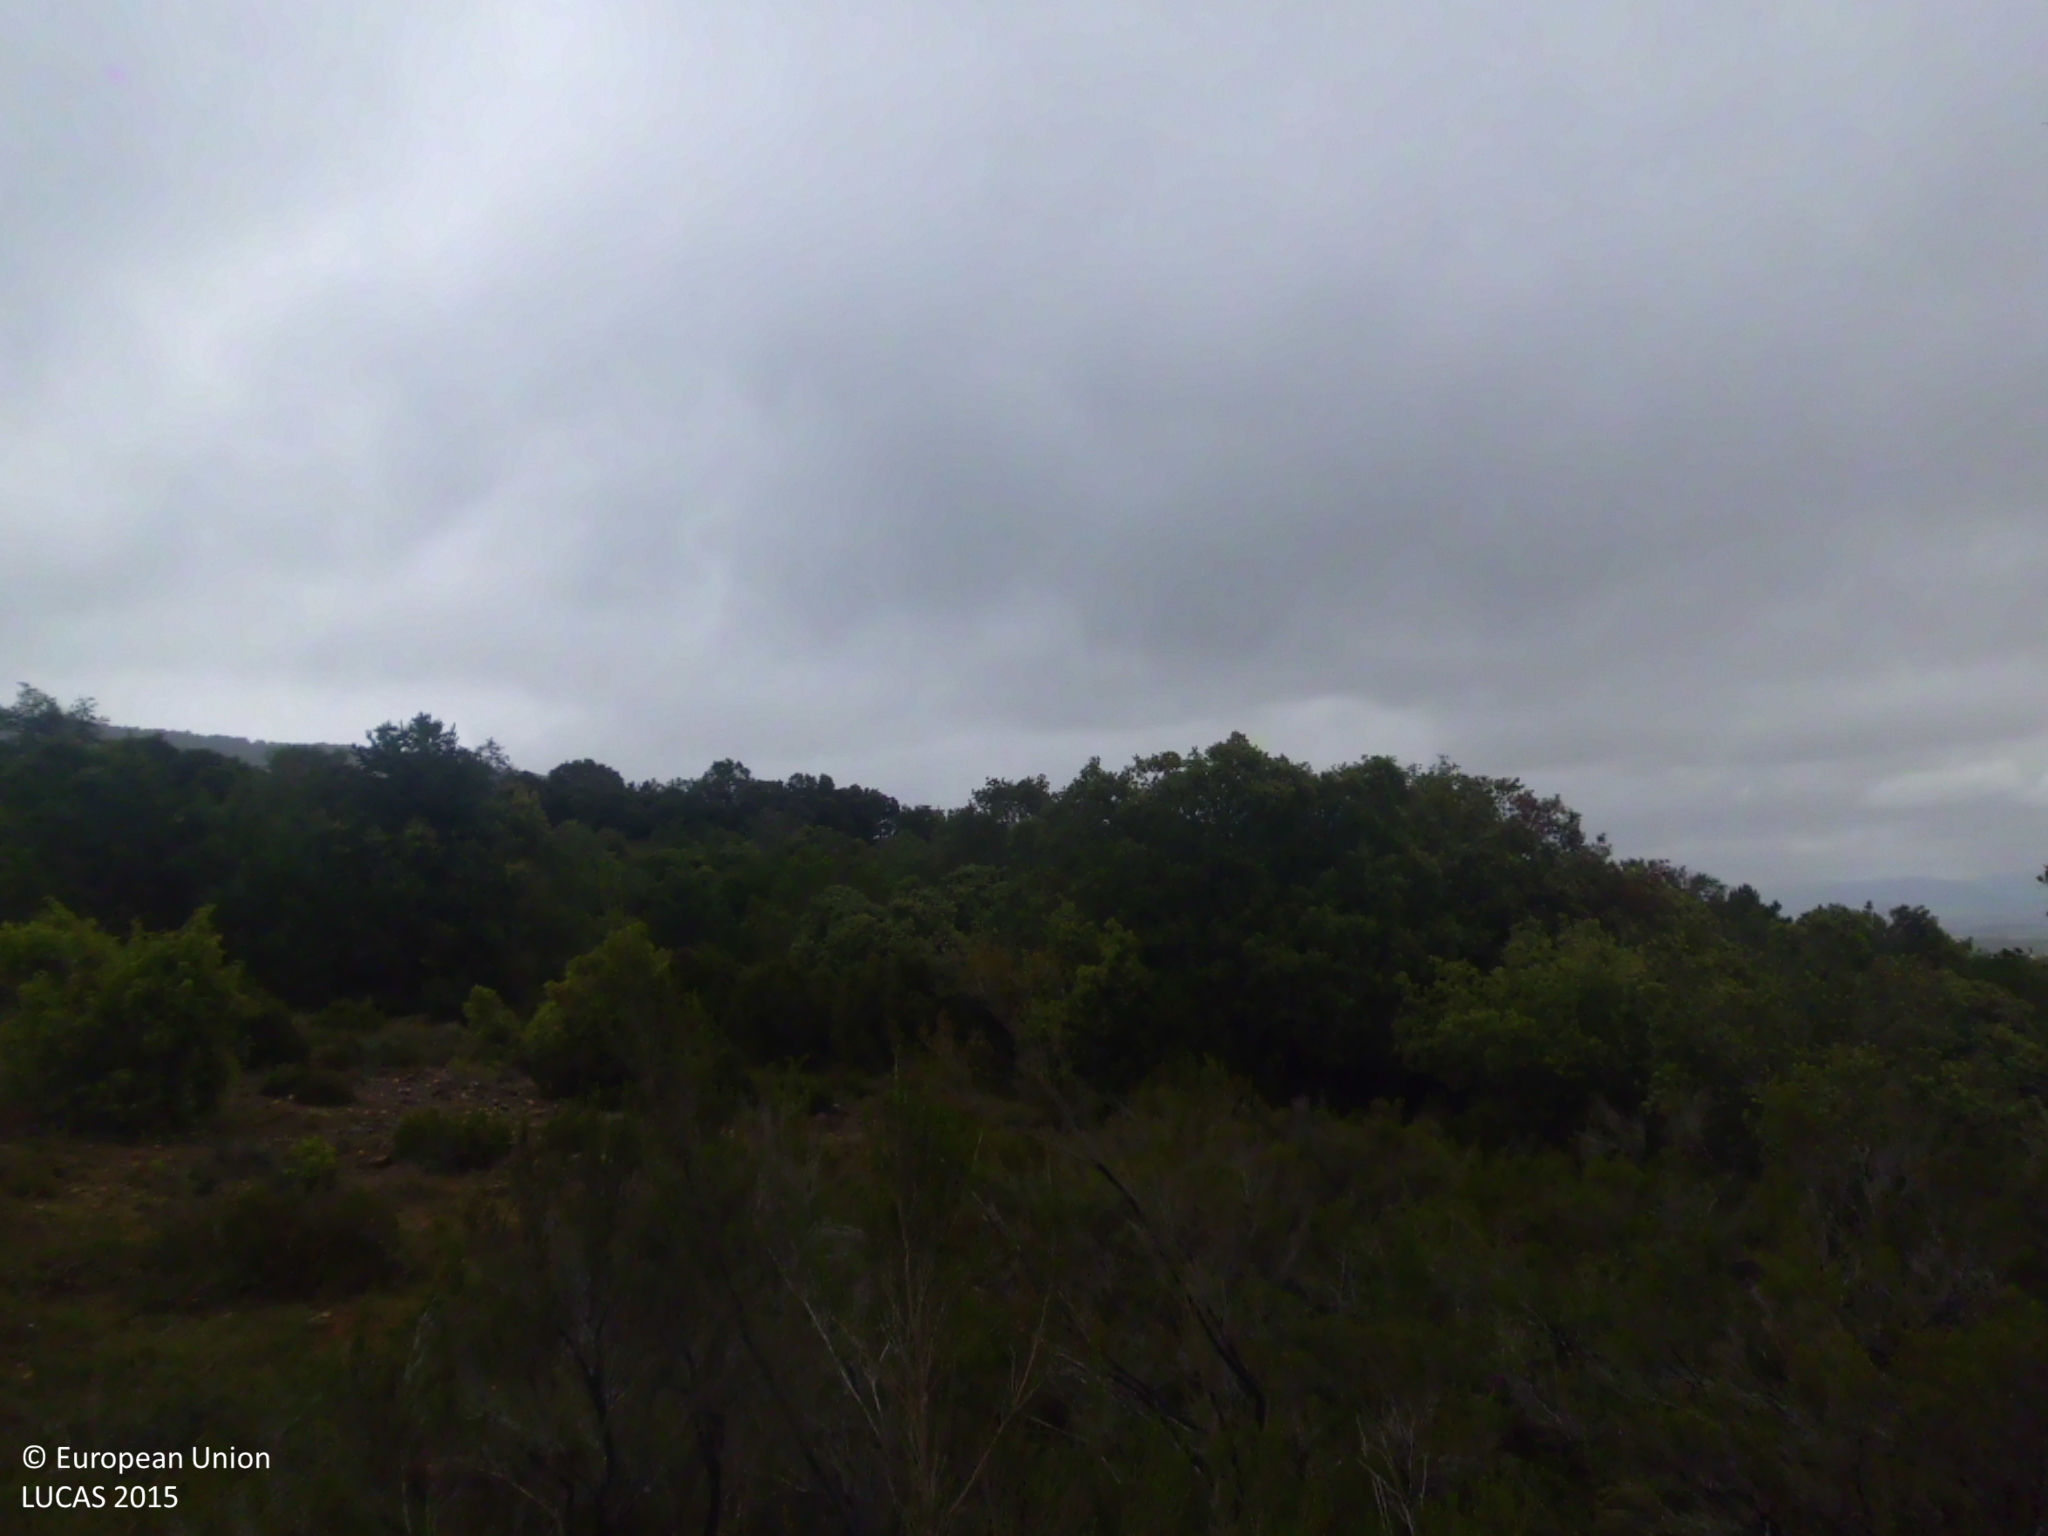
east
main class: Woodland
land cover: Broadleaved woodland
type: acidophilous oak and oak-birch forest
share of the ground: > 75 %
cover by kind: broadleaved forest trees 75 %, shrubs 25 %
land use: Semi-natural and natural areas not in use
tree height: > 5 m
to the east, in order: Broadleaved woodland; Shrubland with sparse tree cover; Fences; Broadleaved woodland; Grassland without tree/shrub cover
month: June
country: ES
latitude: 42.7293
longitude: -3.1120
